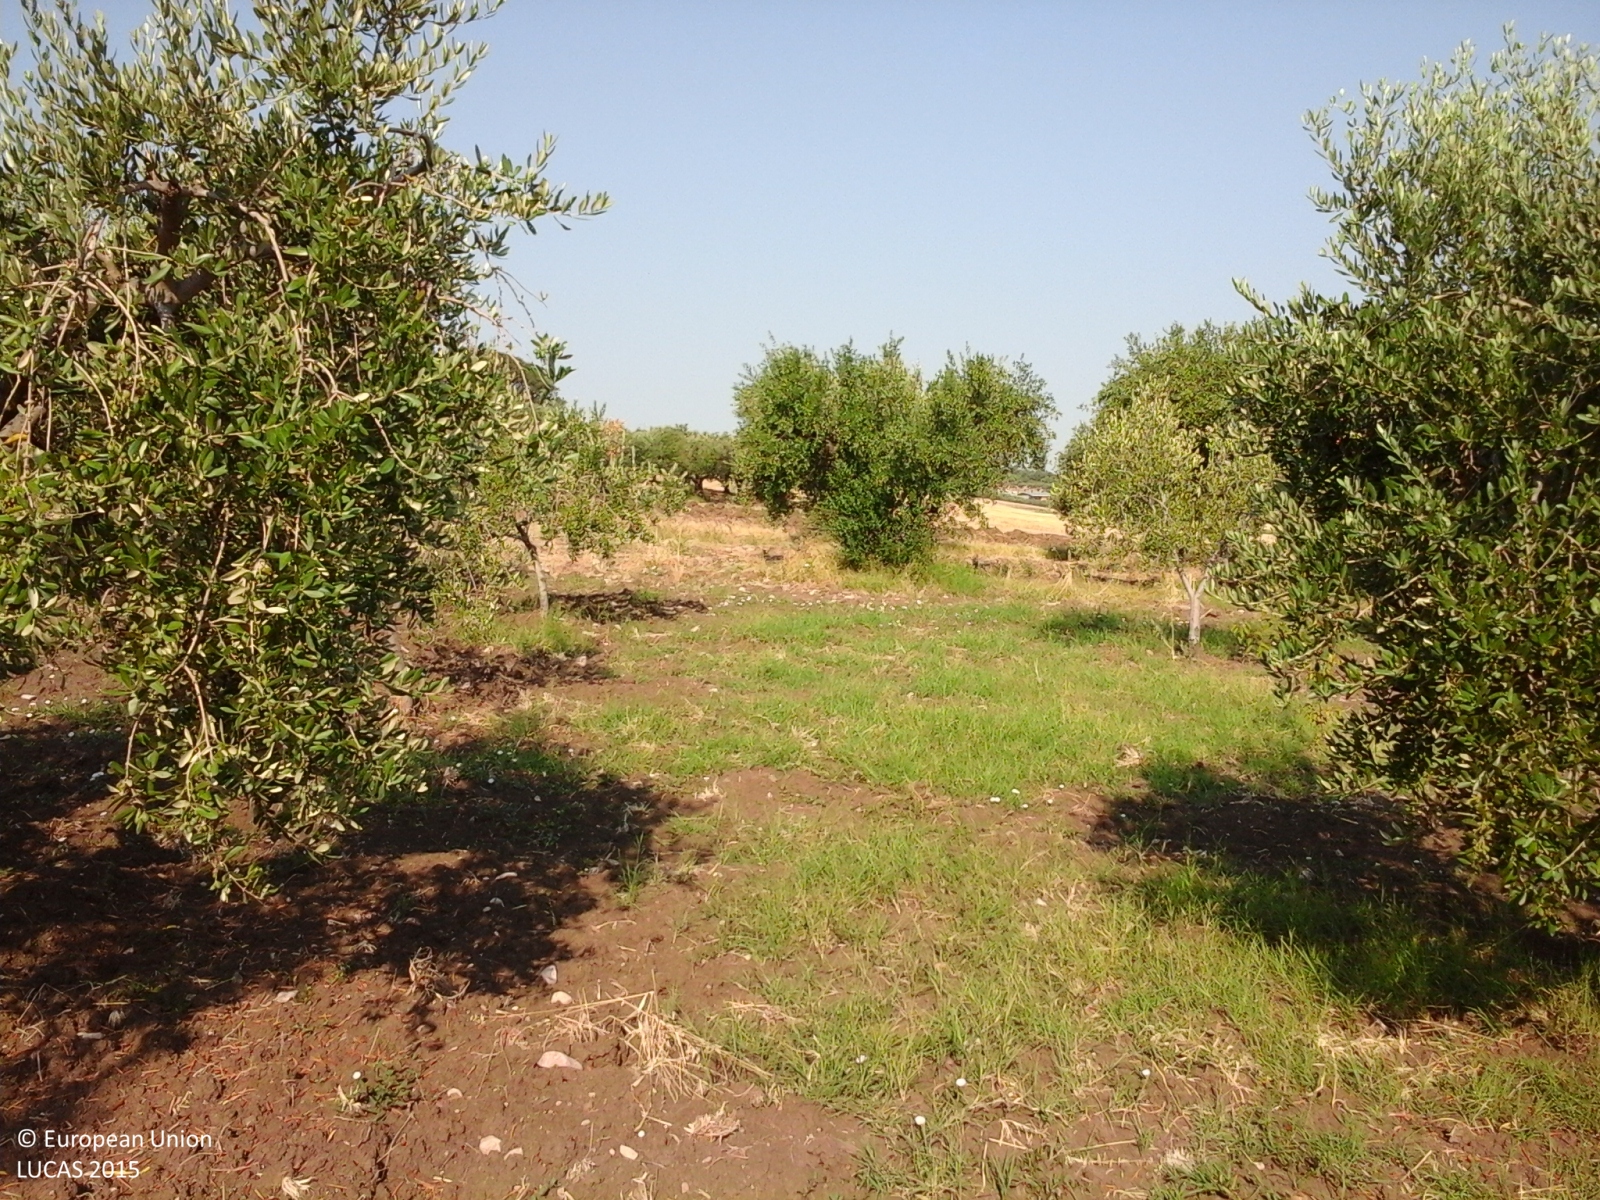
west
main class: Cropland
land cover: Olive groves
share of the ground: > 75 %
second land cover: Spontaneously vegetated surfaces
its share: > 75 %
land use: Agriculture (excluding fallow land and kitchen gardens)
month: August
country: IT
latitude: 41.9770
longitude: 14.8485
